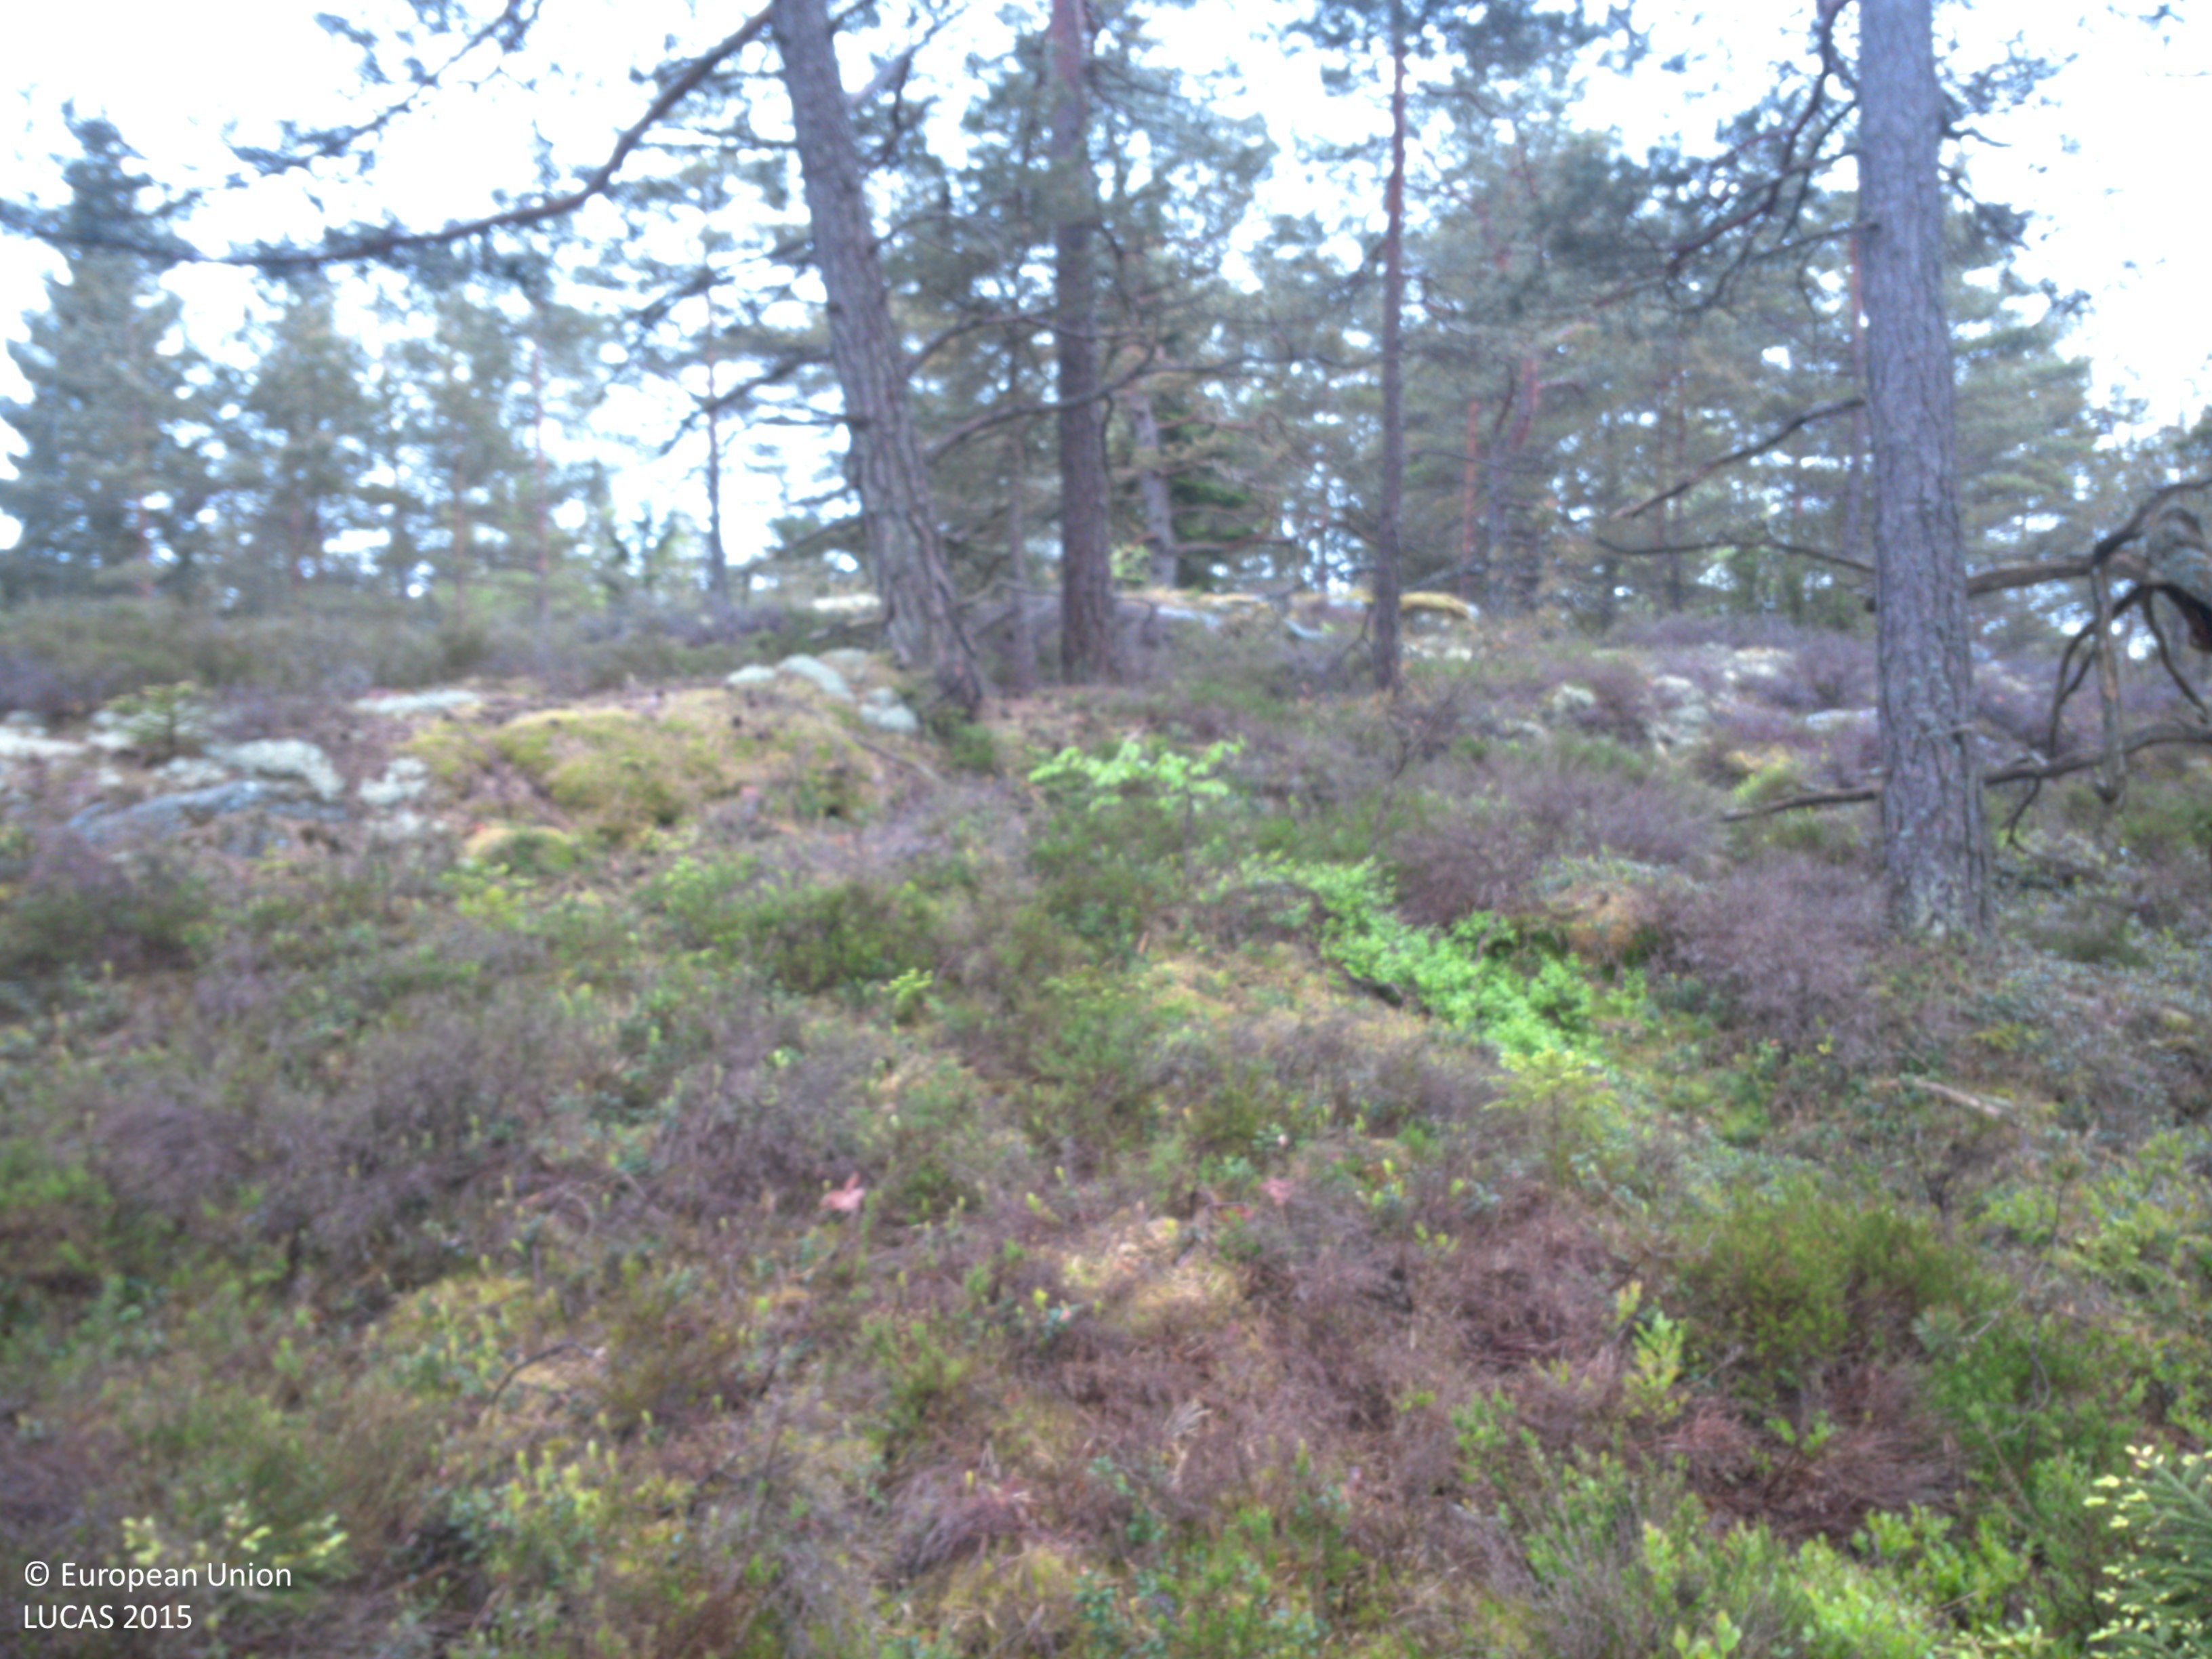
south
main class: Woodland
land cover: Pine dominated coniferous woodland
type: boreal forest
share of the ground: 50 - 75 %
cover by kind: coniferous forest trees 65 %, herbaceous plants 30 %, broadleaved forest trees 5 %
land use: Forestry
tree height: > 5 m
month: May
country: SE
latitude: 58.3177
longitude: 11.6184
